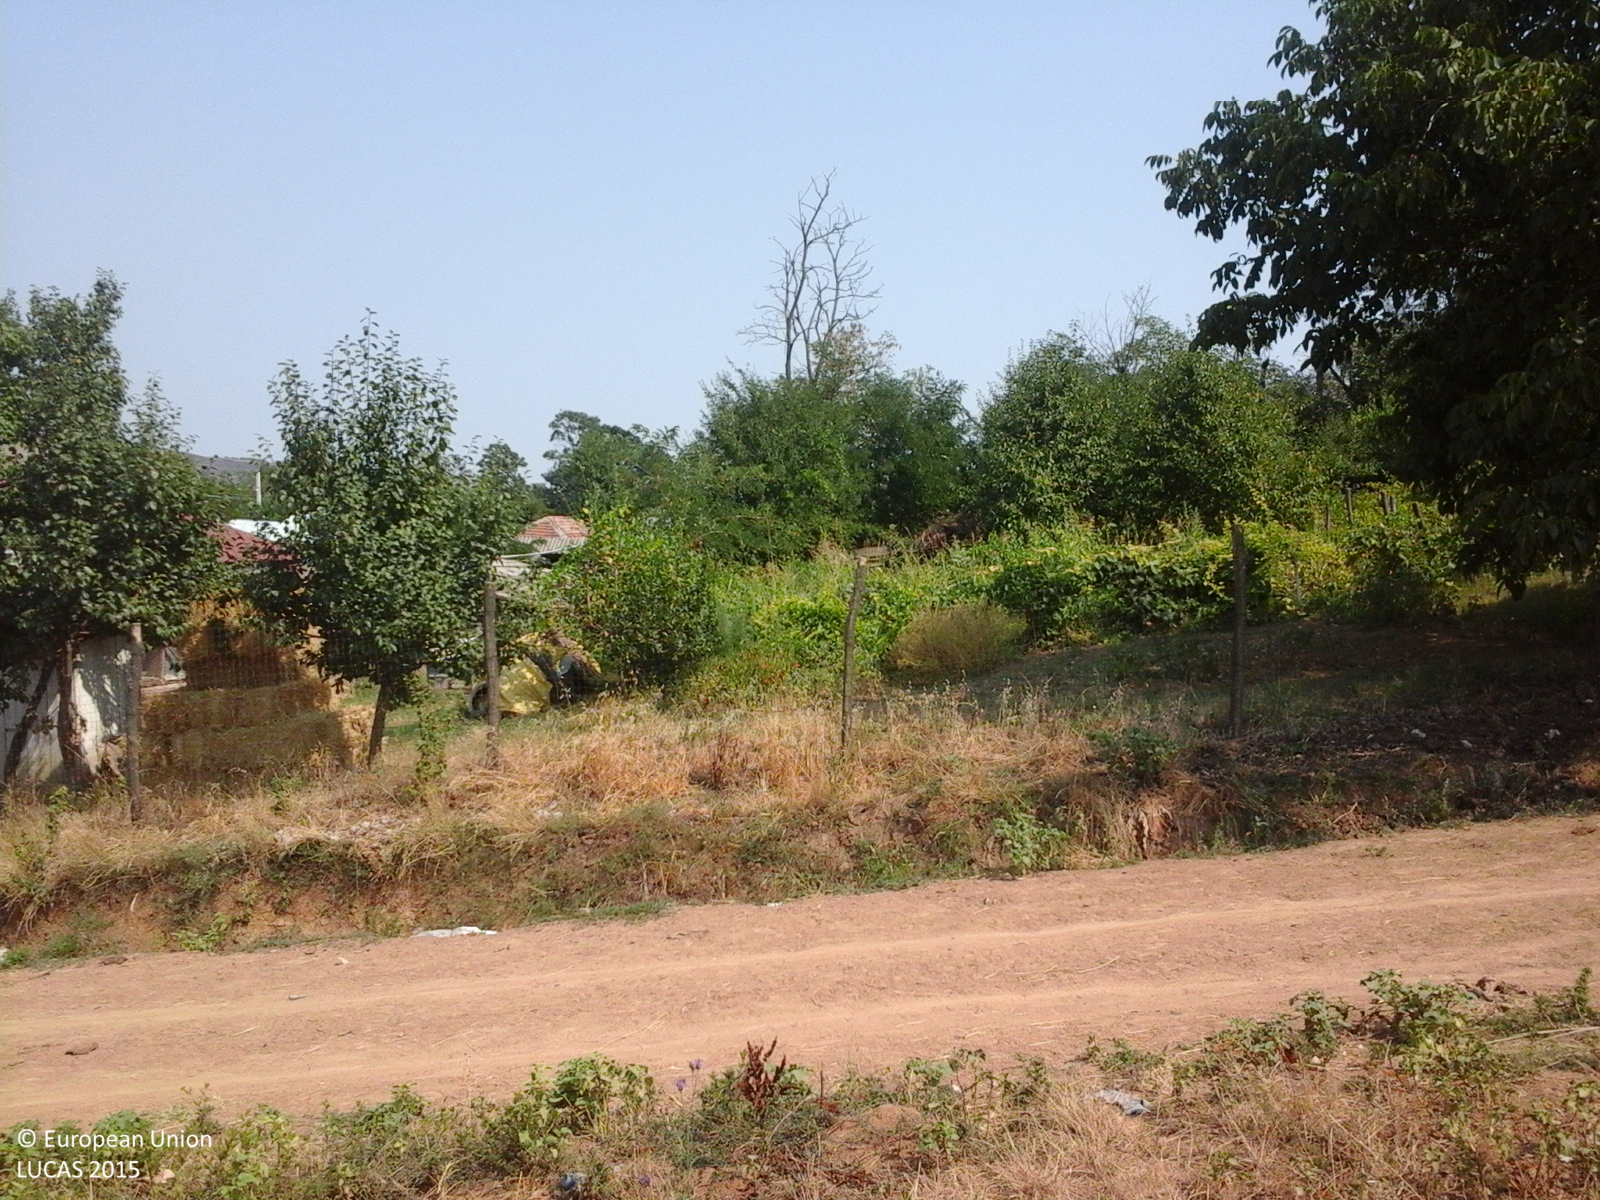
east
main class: Grassland
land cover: Grassland without tree/shrub cover
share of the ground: > 75 %
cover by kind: herbaceous plants 100 %
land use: Agriculture (excluding fallow land and kitchen gardens)
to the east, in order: Grassland without tree/shrub cover; Lines of trees; Grassland without tree/shrub cover; Fences; Grass margins; Tracks; Artificial constructions in urban areas
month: August
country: RO
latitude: 44.3615
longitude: 23.6177
